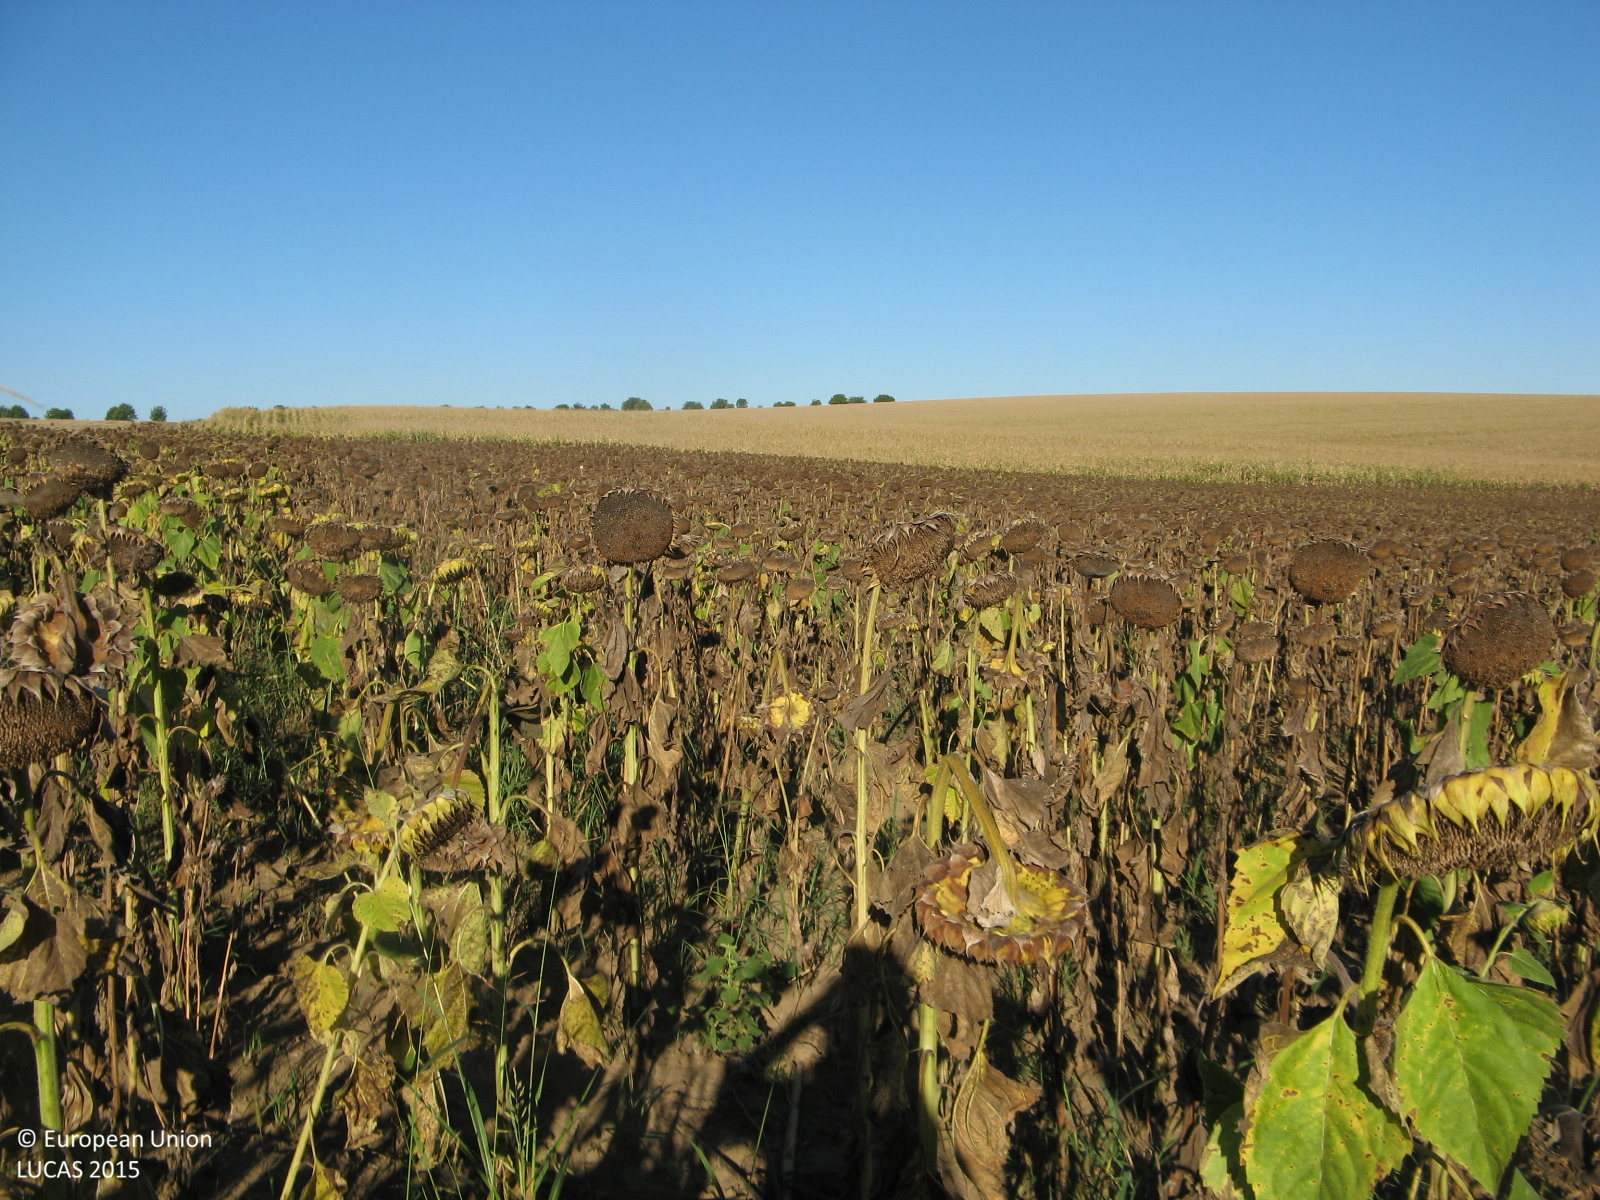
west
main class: Cropland
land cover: Sunflower
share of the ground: > 75 %
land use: Agriculture (excluding fallow land and kitchen gardens)
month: September
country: BG
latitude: 43.6033
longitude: 26.0643
